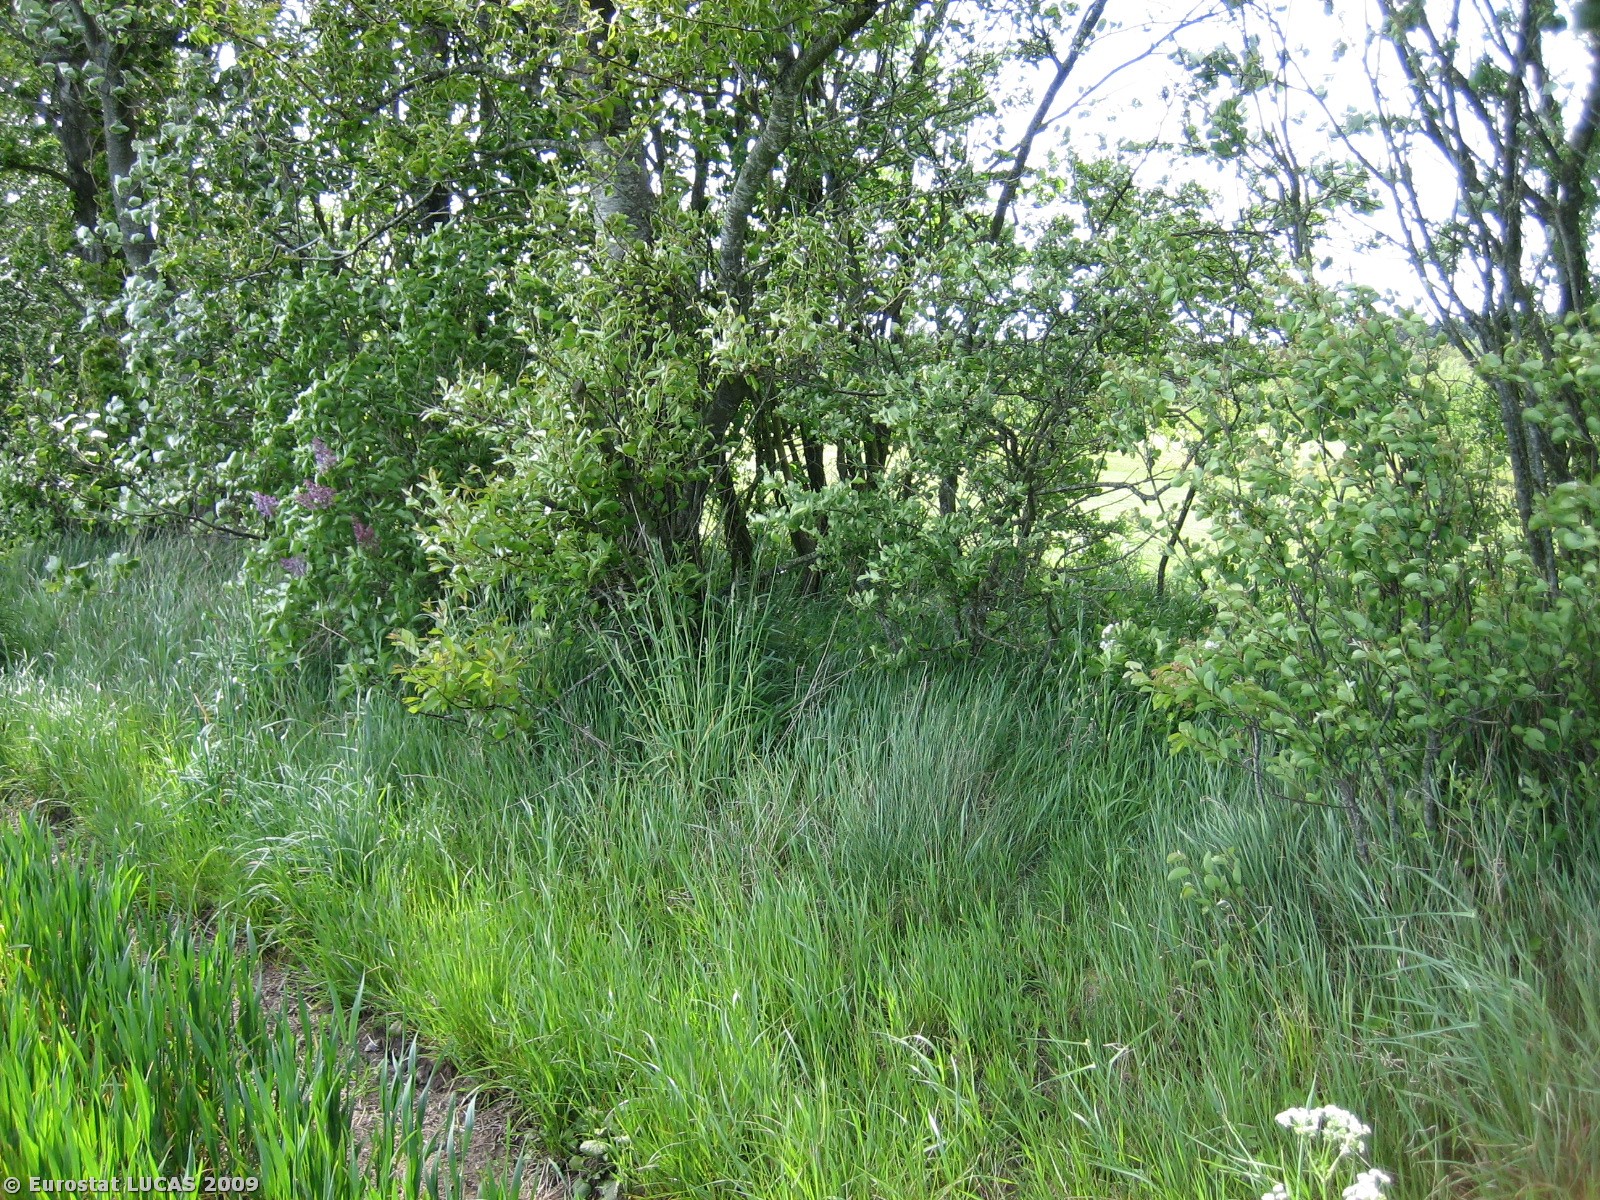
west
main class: Cropland
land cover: Barley
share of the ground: > 75 %
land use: Agriculture (excluding fallow land and kitchen gardens)
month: May
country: DK
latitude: 55.9990
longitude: 8.4783
